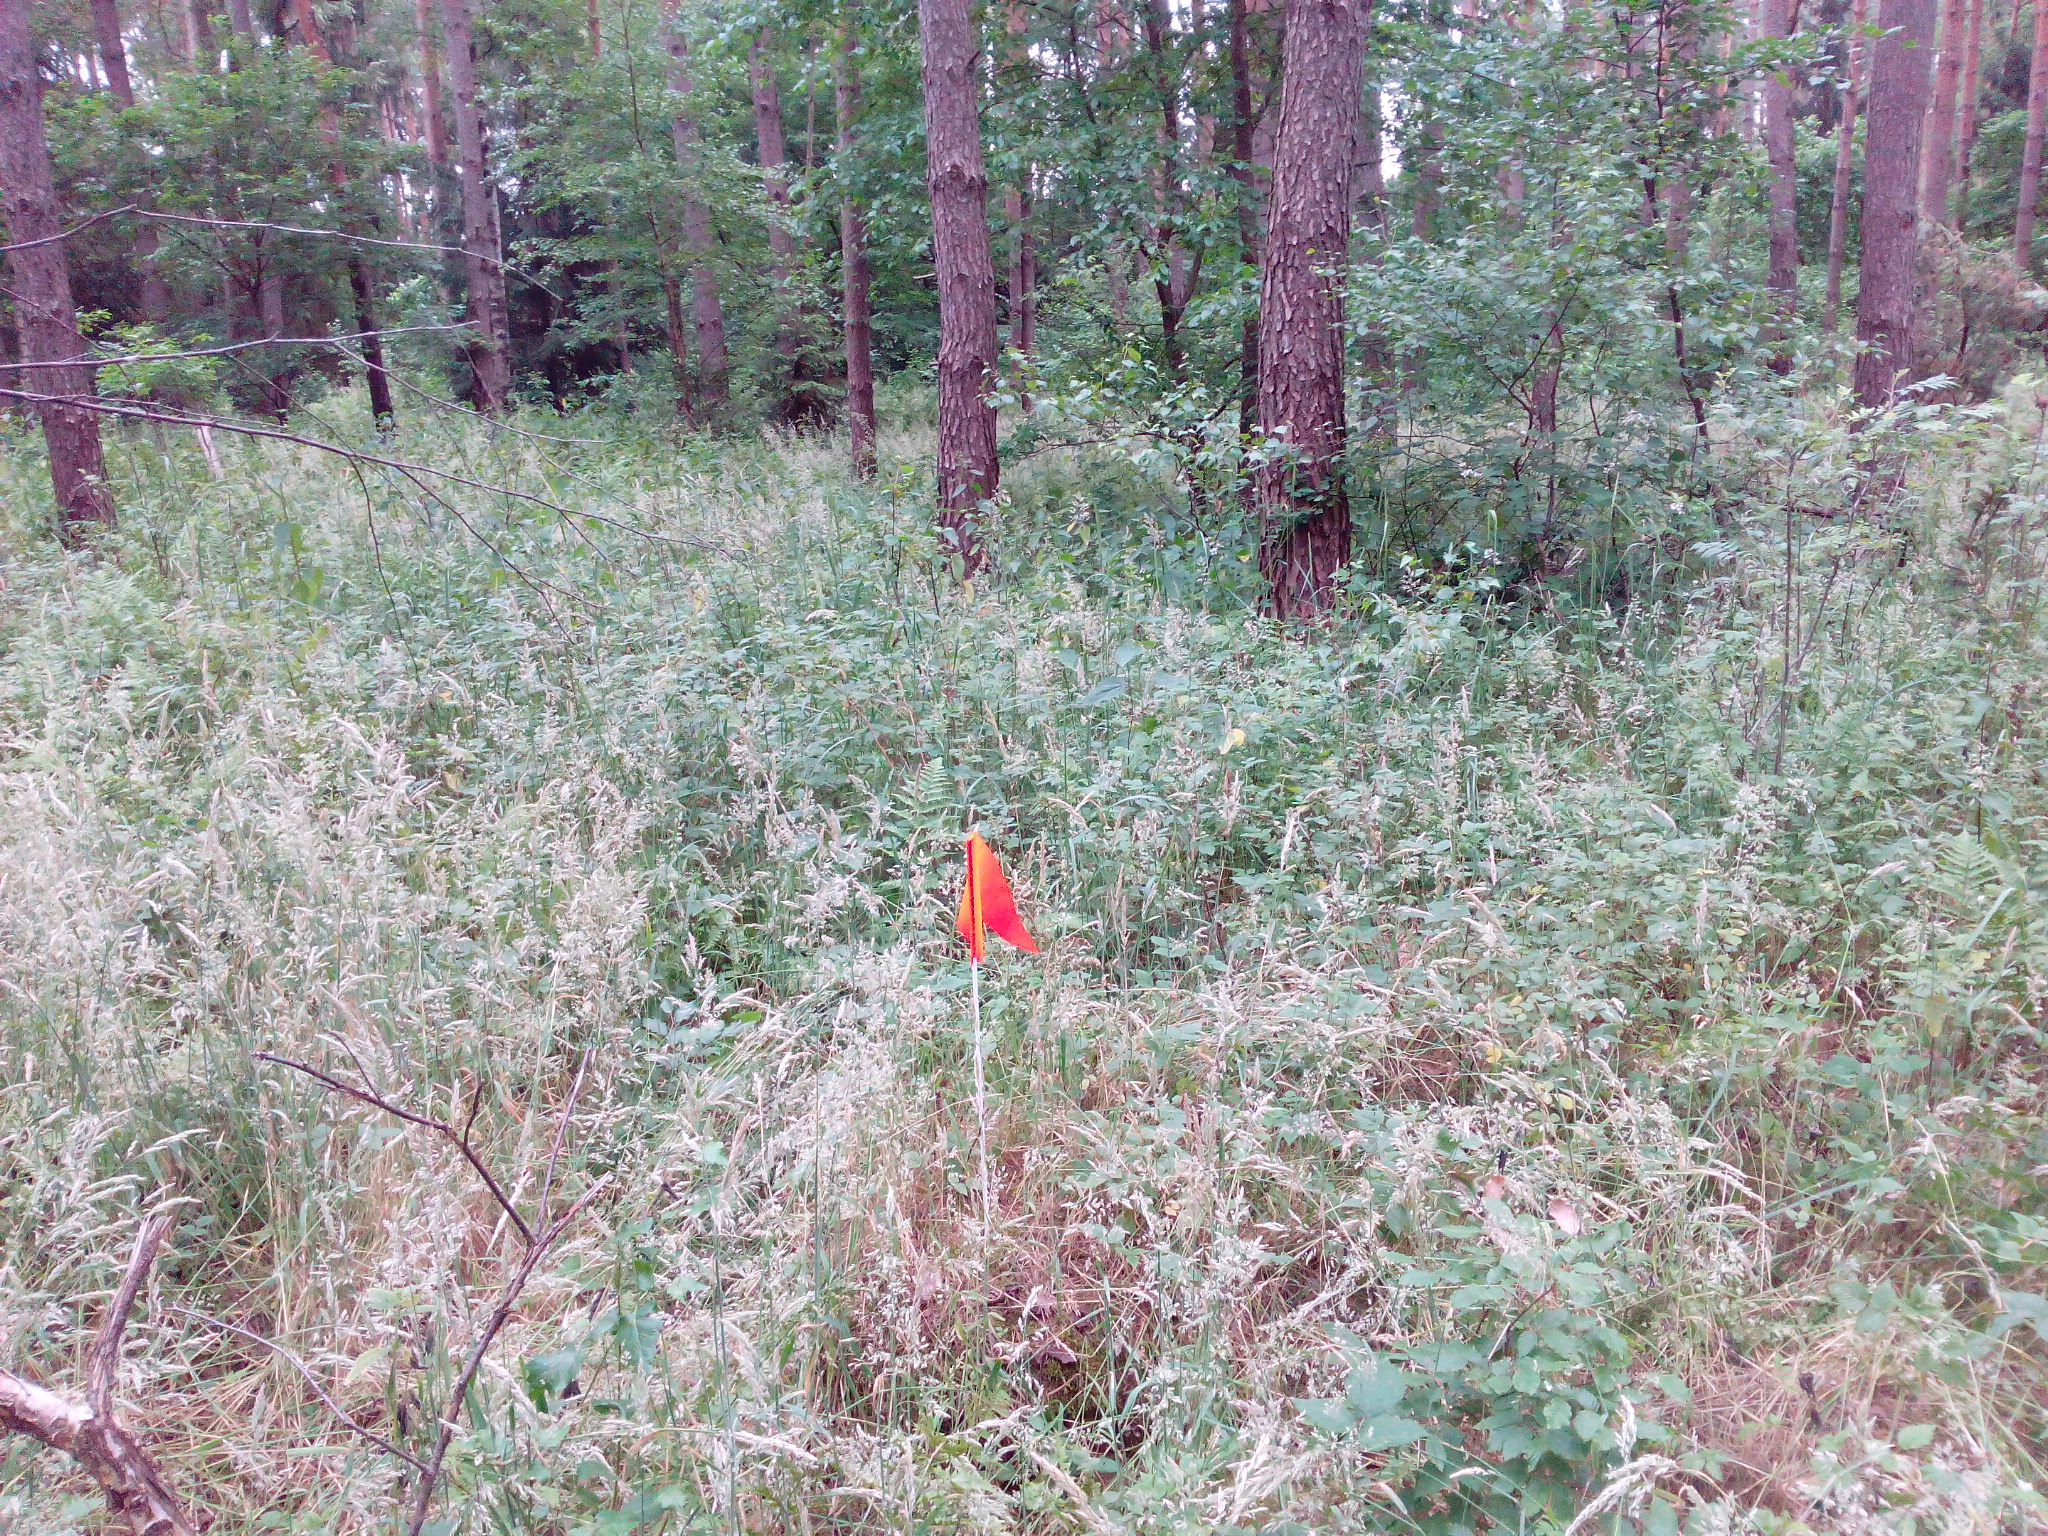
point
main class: Woodland
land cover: Pine dominated coniferous woodland
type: hemiboreal forest and nemoral coniferous forest and mixed broadleaved-coniferous forest
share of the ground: > 75 %
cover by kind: coniferous forest trees 80 %, herbaceous plants 10 %, broadleaved forest trees 5 %, shrubs 5 %
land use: Forestry
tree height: > 5 m
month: June
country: DE
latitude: 52.6110
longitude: 9.8671
